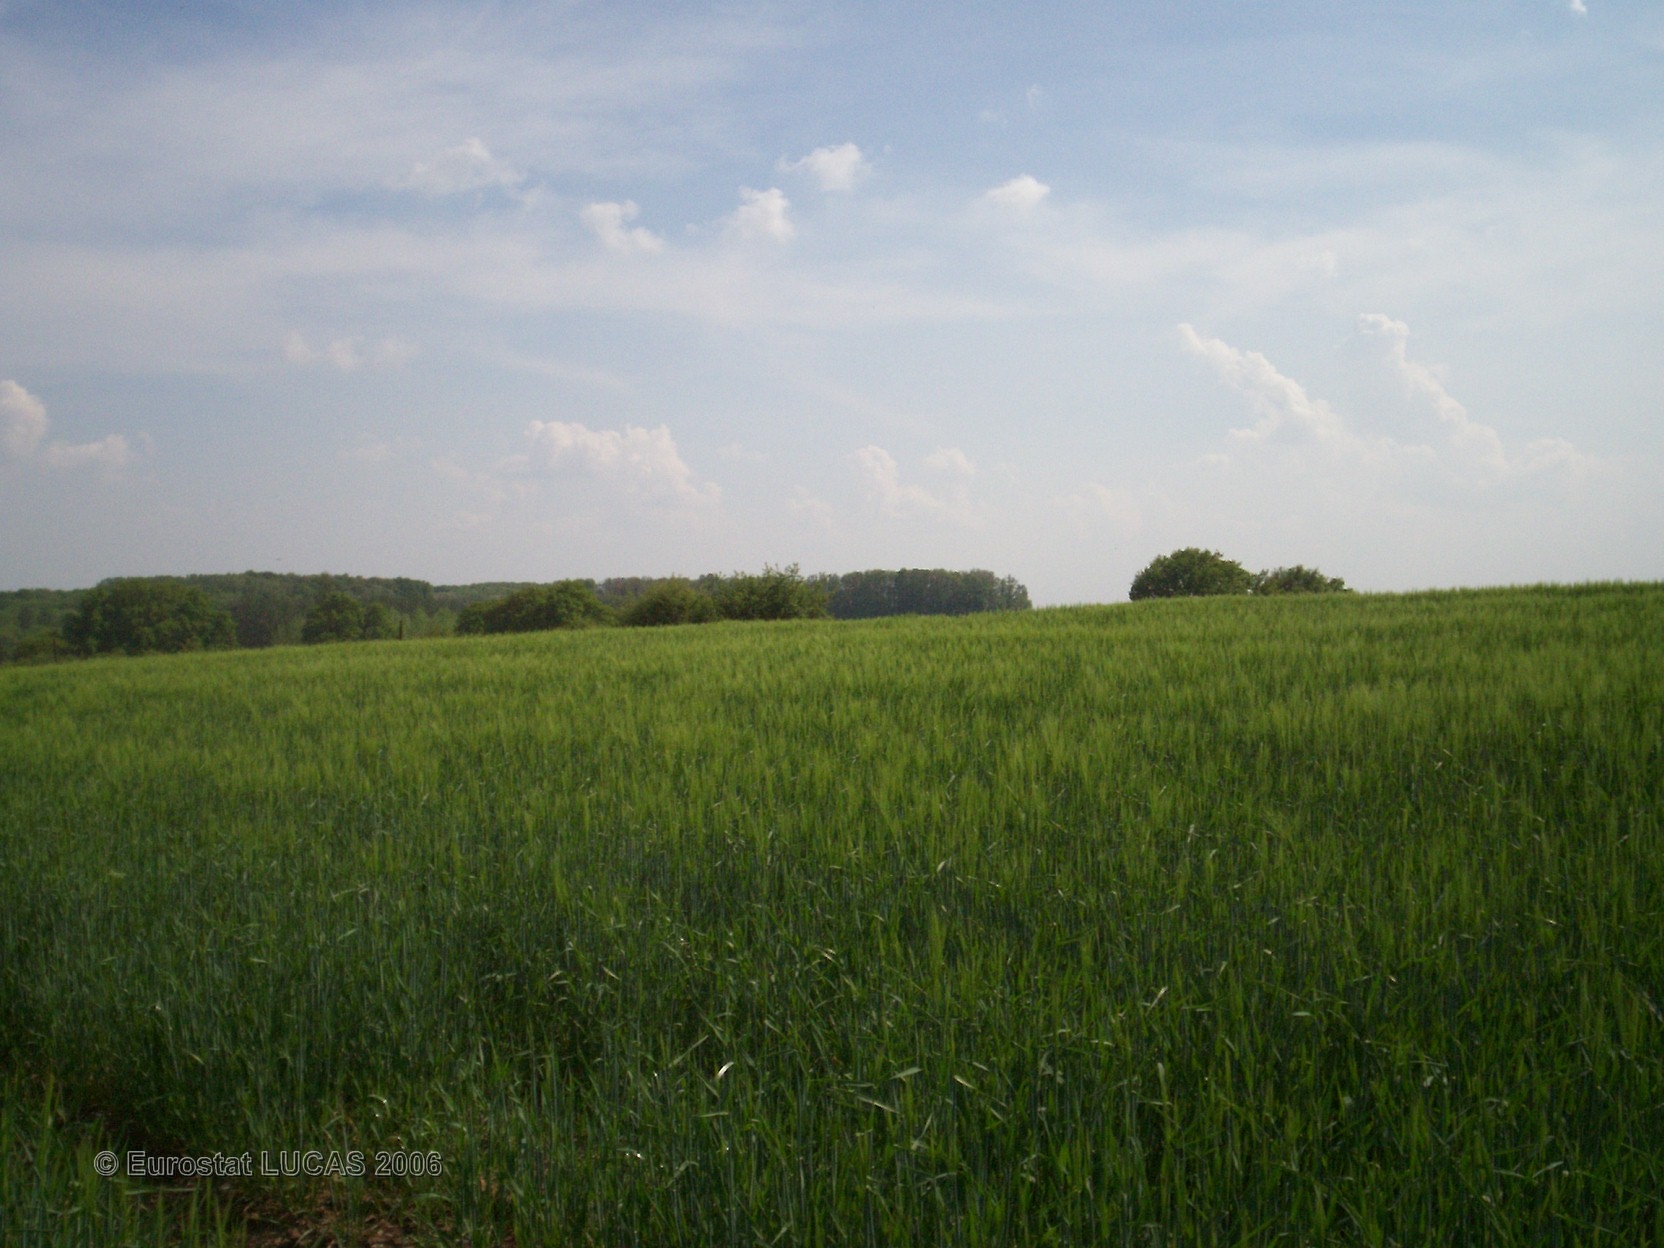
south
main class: Cropland
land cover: Barley
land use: Agriculture (excluding fallow land and kitchen gardens)
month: May
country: FR
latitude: 49.6632
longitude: 4.3015
